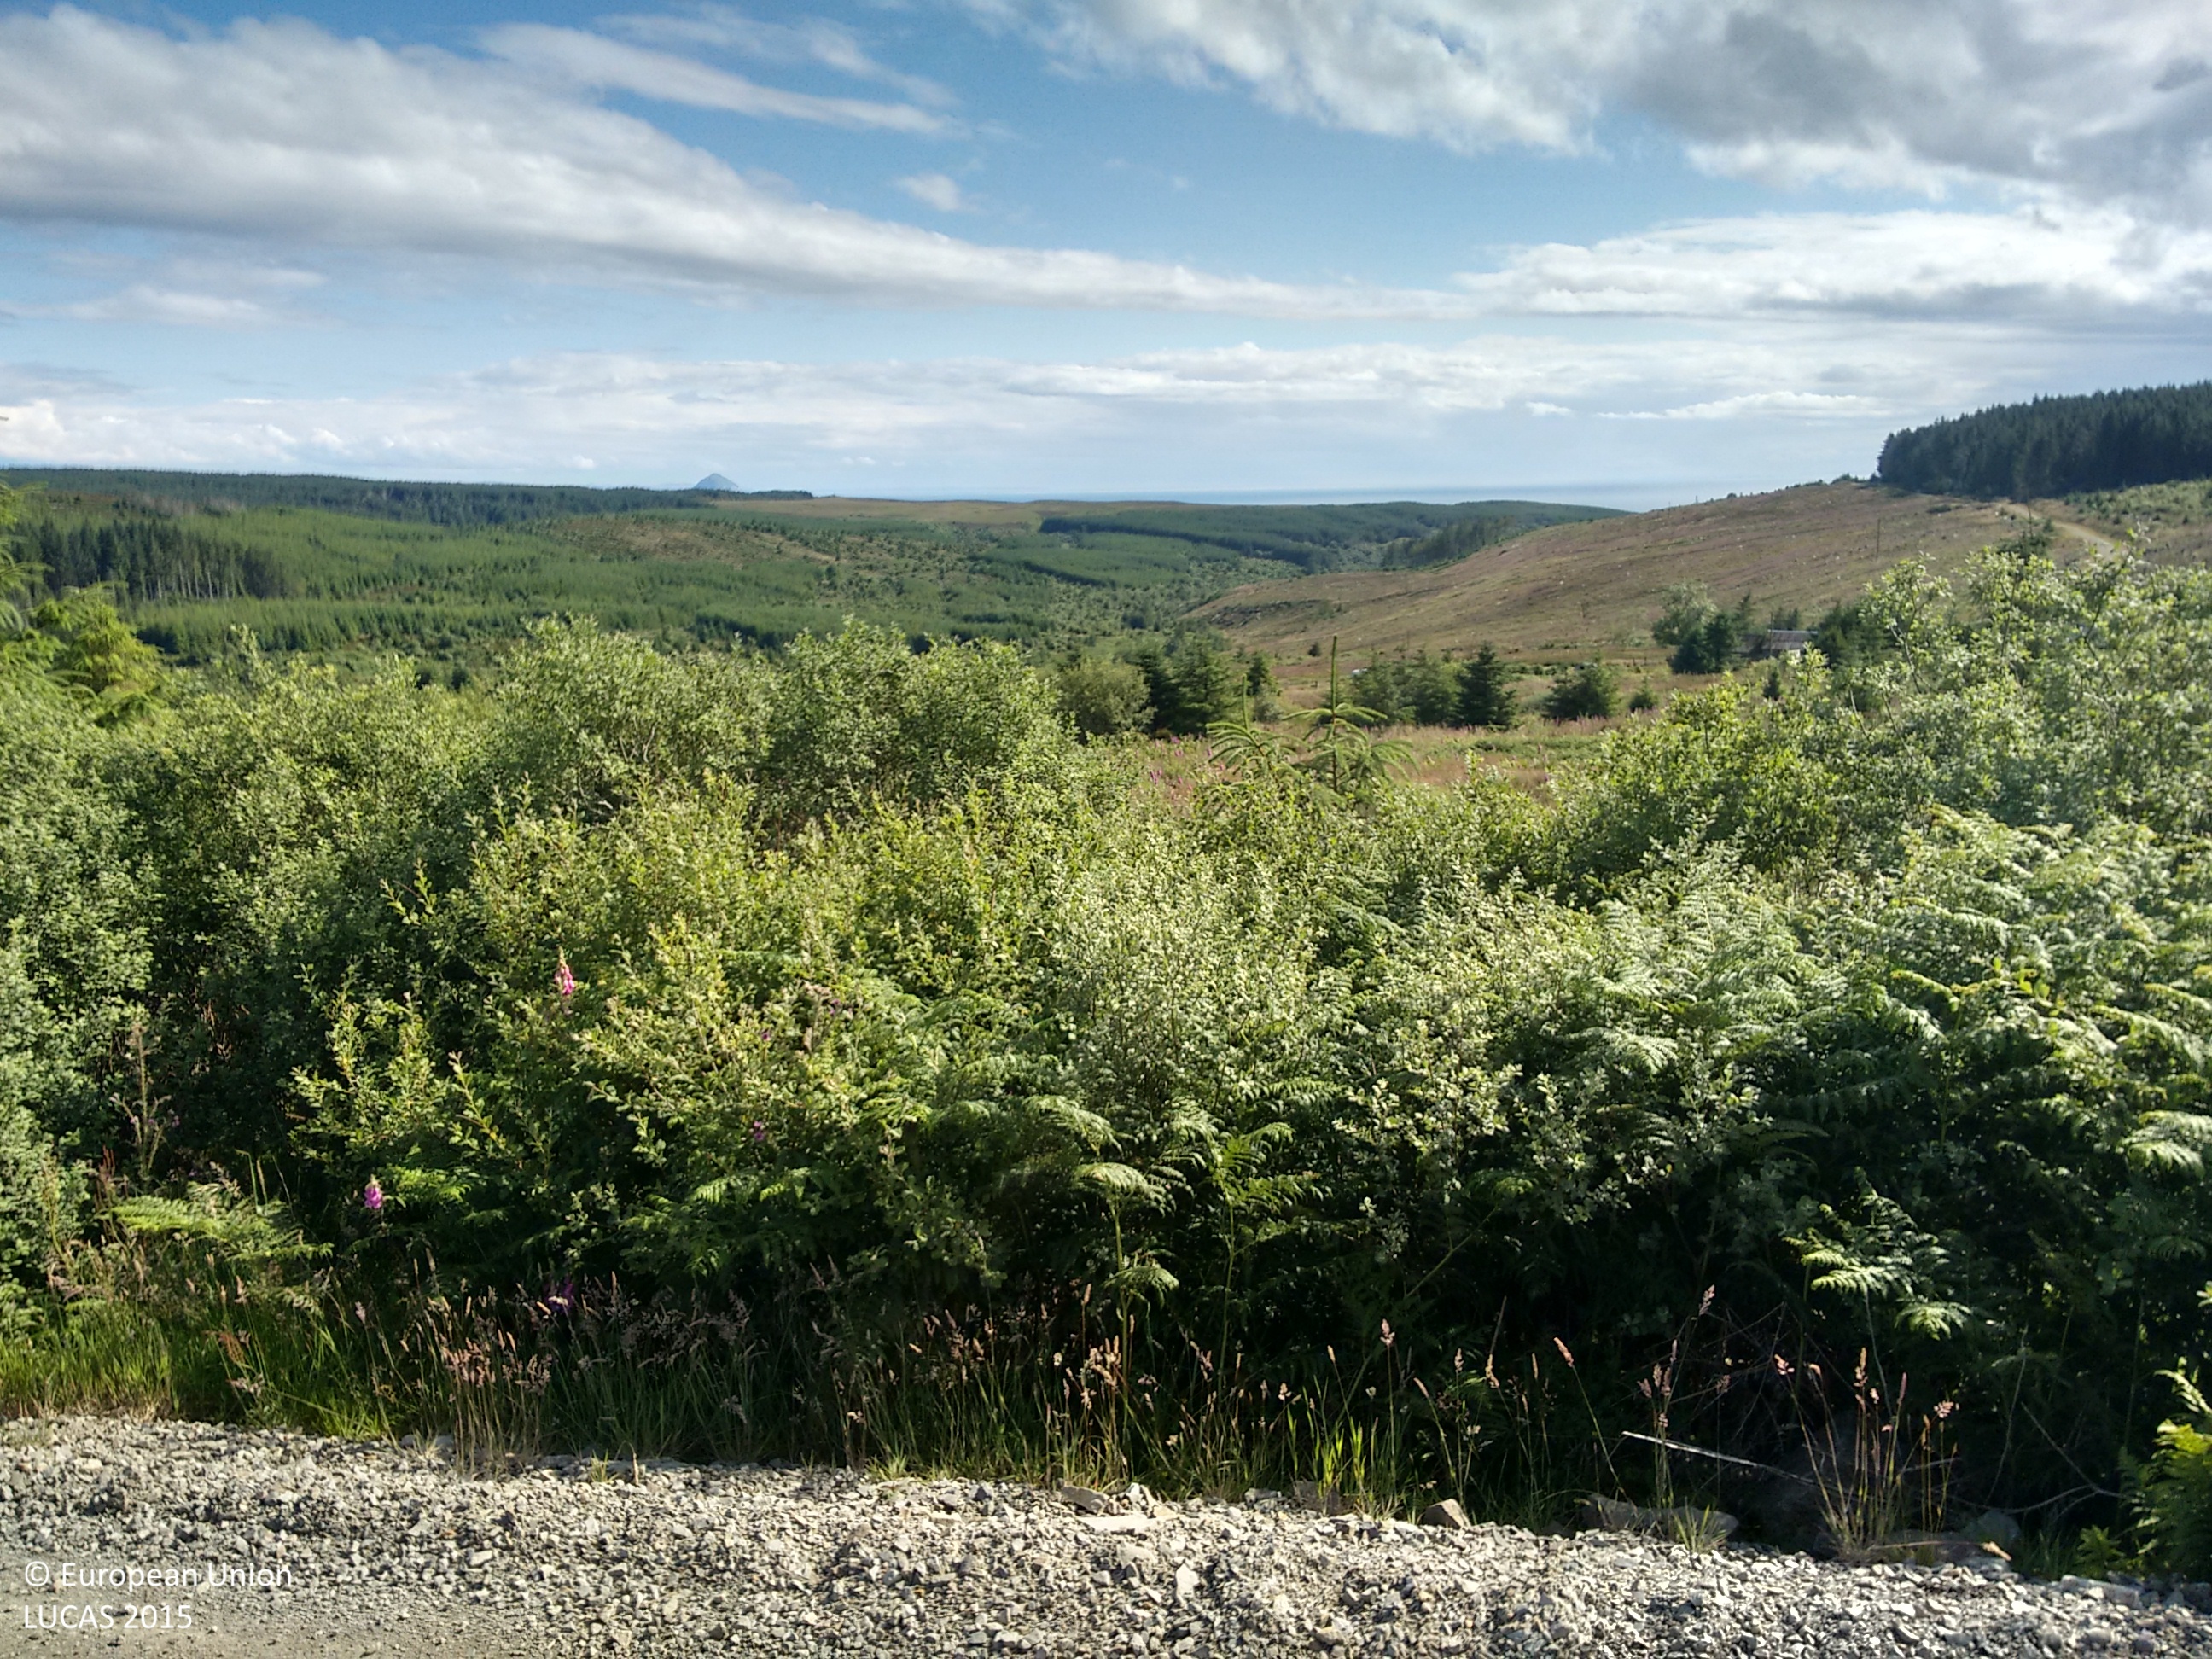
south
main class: Shrubland
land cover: Shrubland with sparse tree cover
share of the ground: > 75 %
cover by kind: shrubs 95 %, coniferous forest trees 5 %
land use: Semi-natural and natural areas not in use
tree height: < 5 m
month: July
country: GB
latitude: 55.4768
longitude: -5.1945
